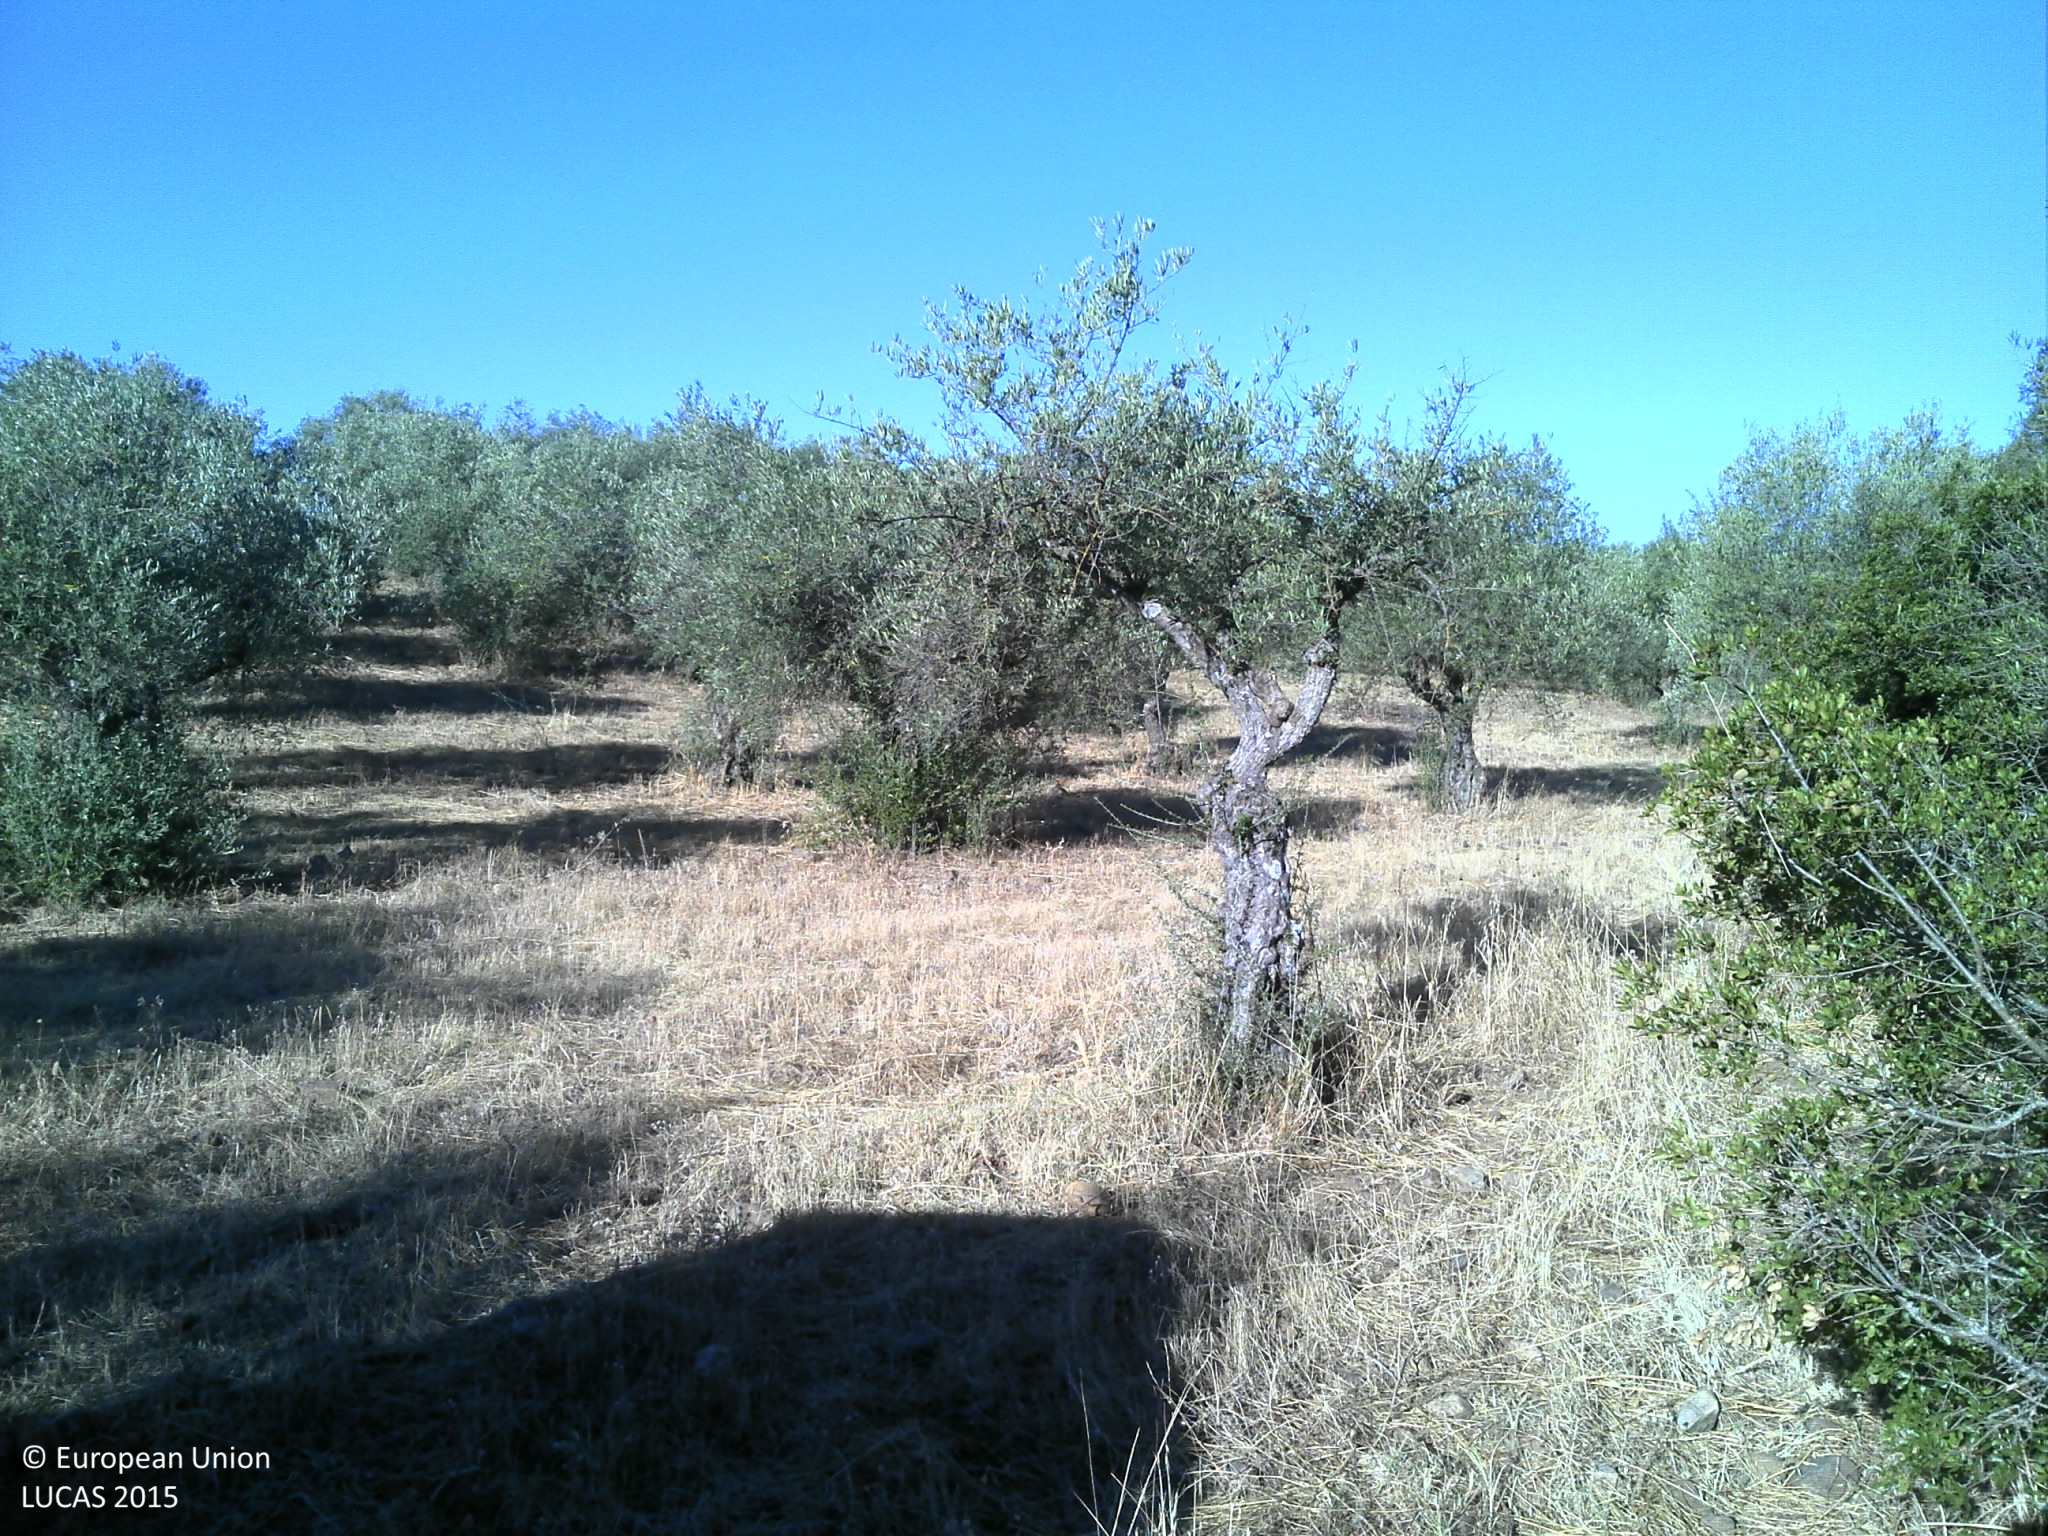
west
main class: Cropland
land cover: Olive groves
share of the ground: 25 - 50 %
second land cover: Shrubland without tree cover
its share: 10 - 25 %
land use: Agriculture (excluding fallow land and kitchen gardens)
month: July
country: PT
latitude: 39.0967
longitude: -7.0374
